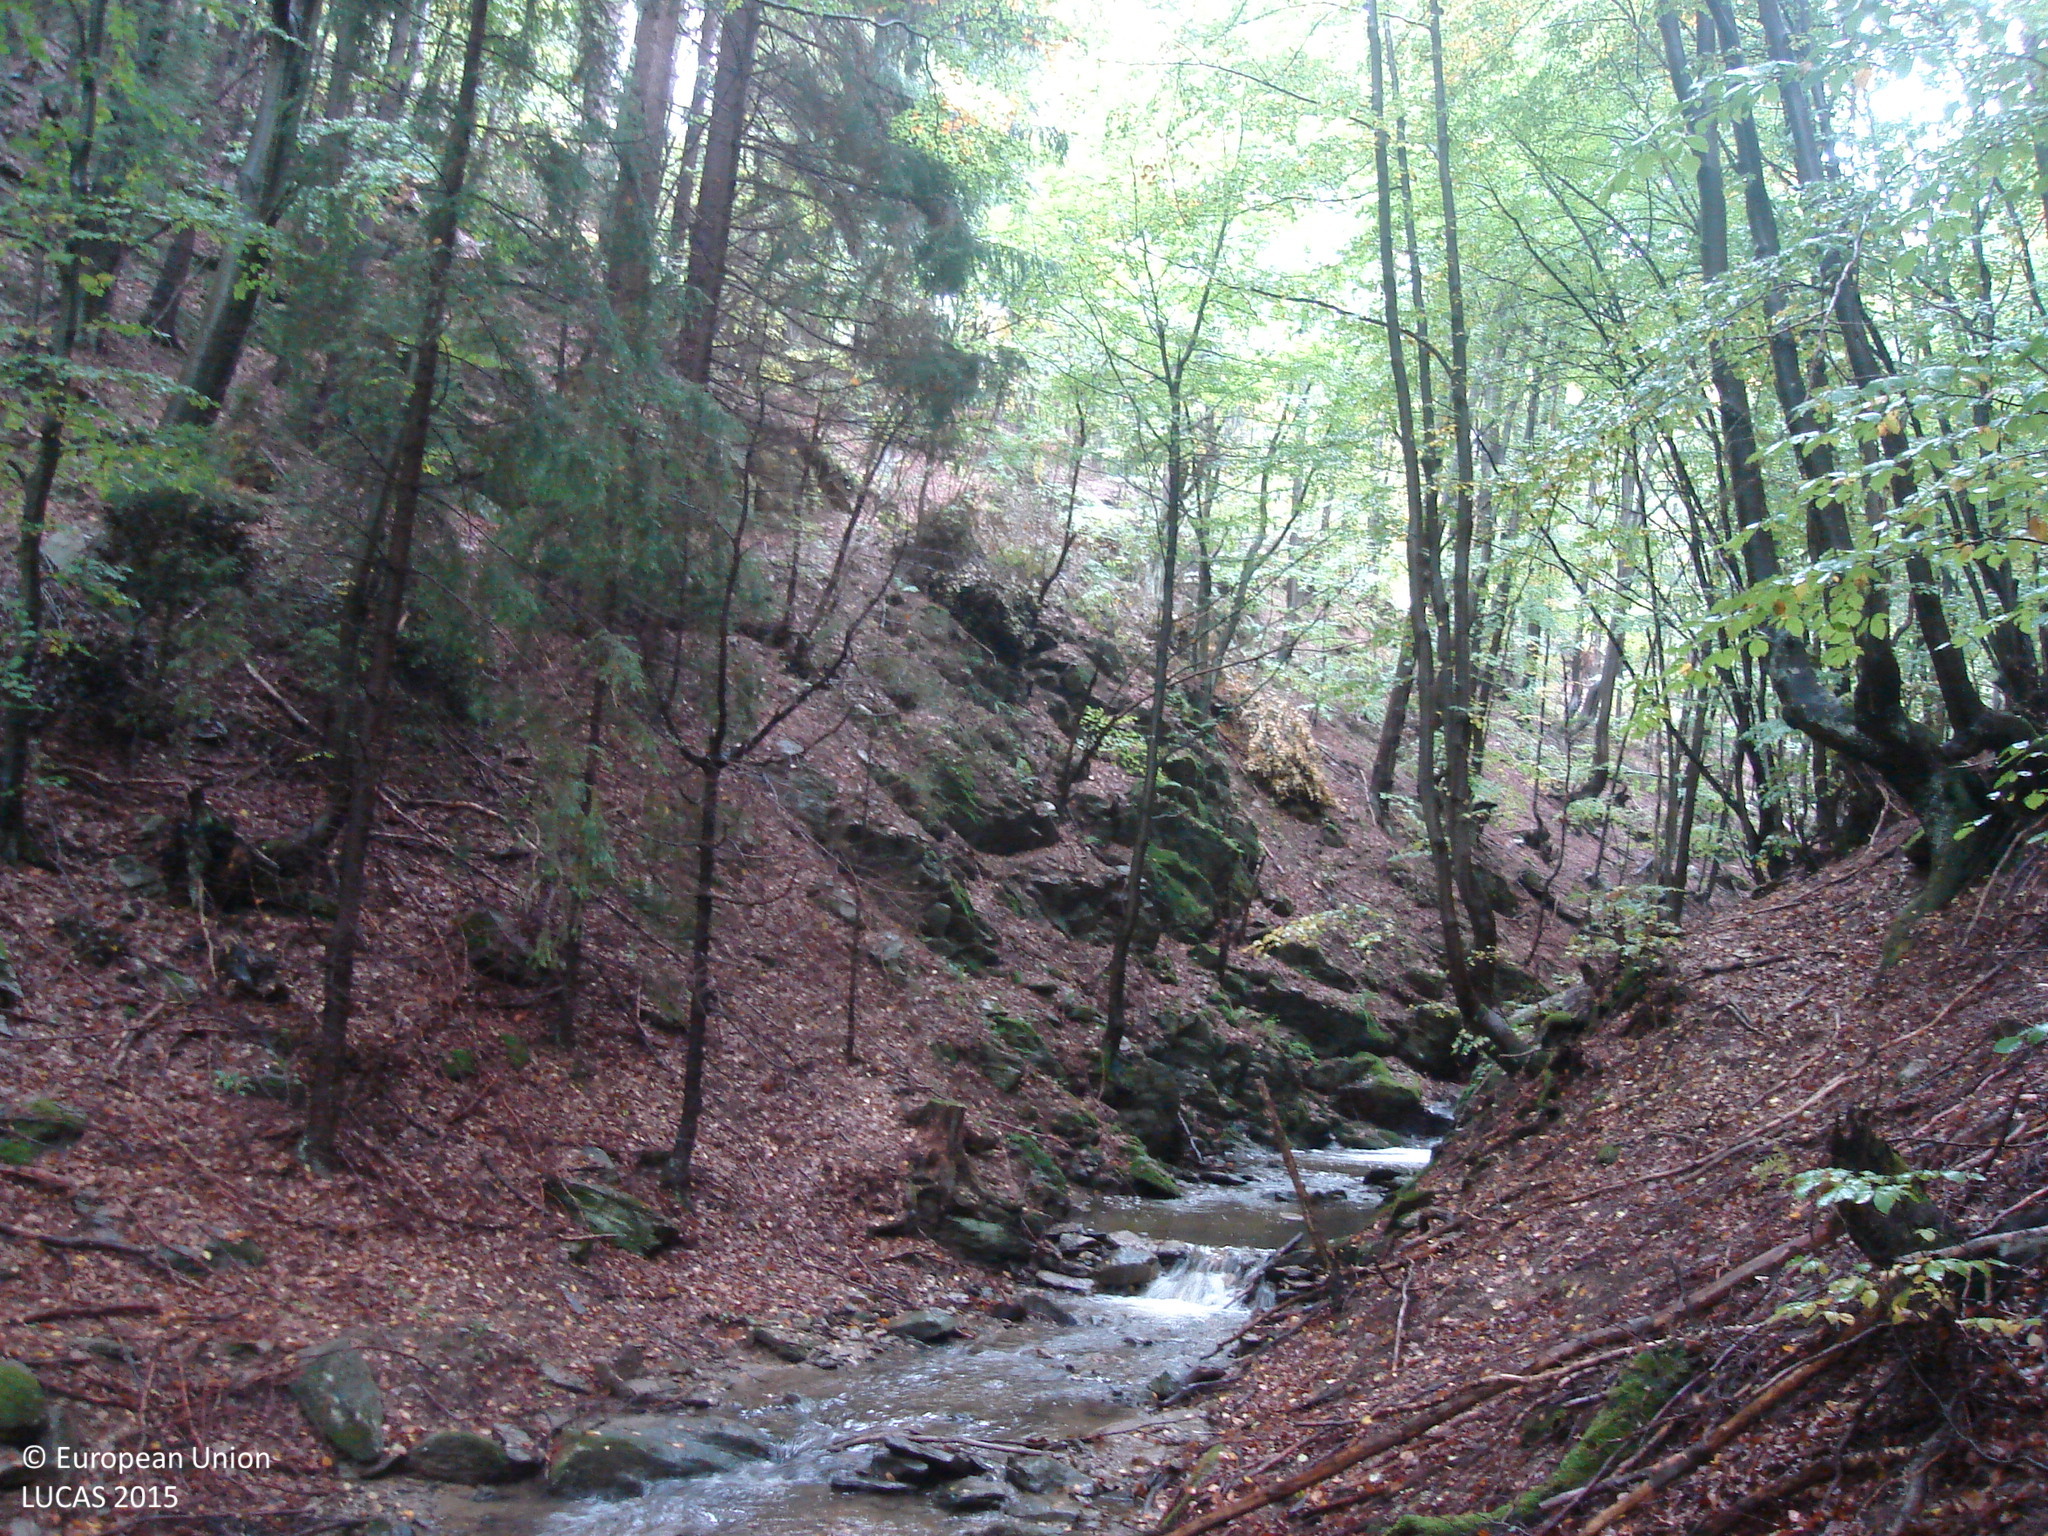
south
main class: Woodland
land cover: Broadleaved woodland
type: beech forest
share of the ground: > 75 %
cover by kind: broadleaved forest trees 95 %, unconsolidated bare surface 5 %
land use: Forestry
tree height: > 5 m
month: October
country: BG
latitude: 42.6715
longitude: 24.3386
